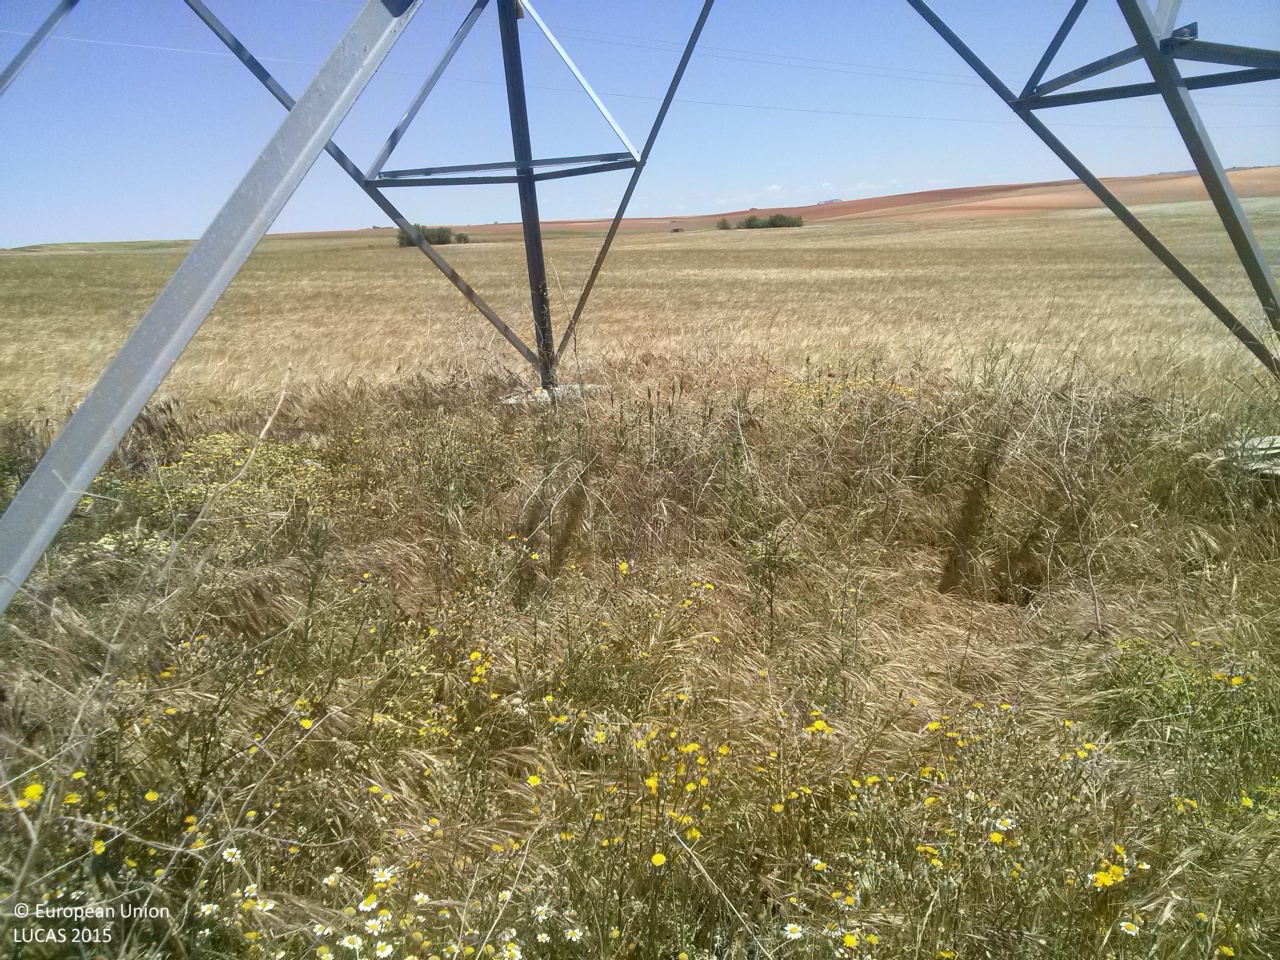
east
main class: Artificial land
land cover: Other artificial areas
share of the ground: < 10 %
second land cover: Barley
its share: > 75 %
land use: Electricity, gas and thermal power distribution
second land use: Agriculture (excluding fallow land and kitchen gardens)
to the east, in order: Artificial constructions in urban areas; Barley; Electric lines; Barley; Grass margins; Single bushes/trees; Grass margins; Tracks; Grass margins; Dry pulses
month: May
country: ES
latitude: 40.3074
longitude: -2.7676
